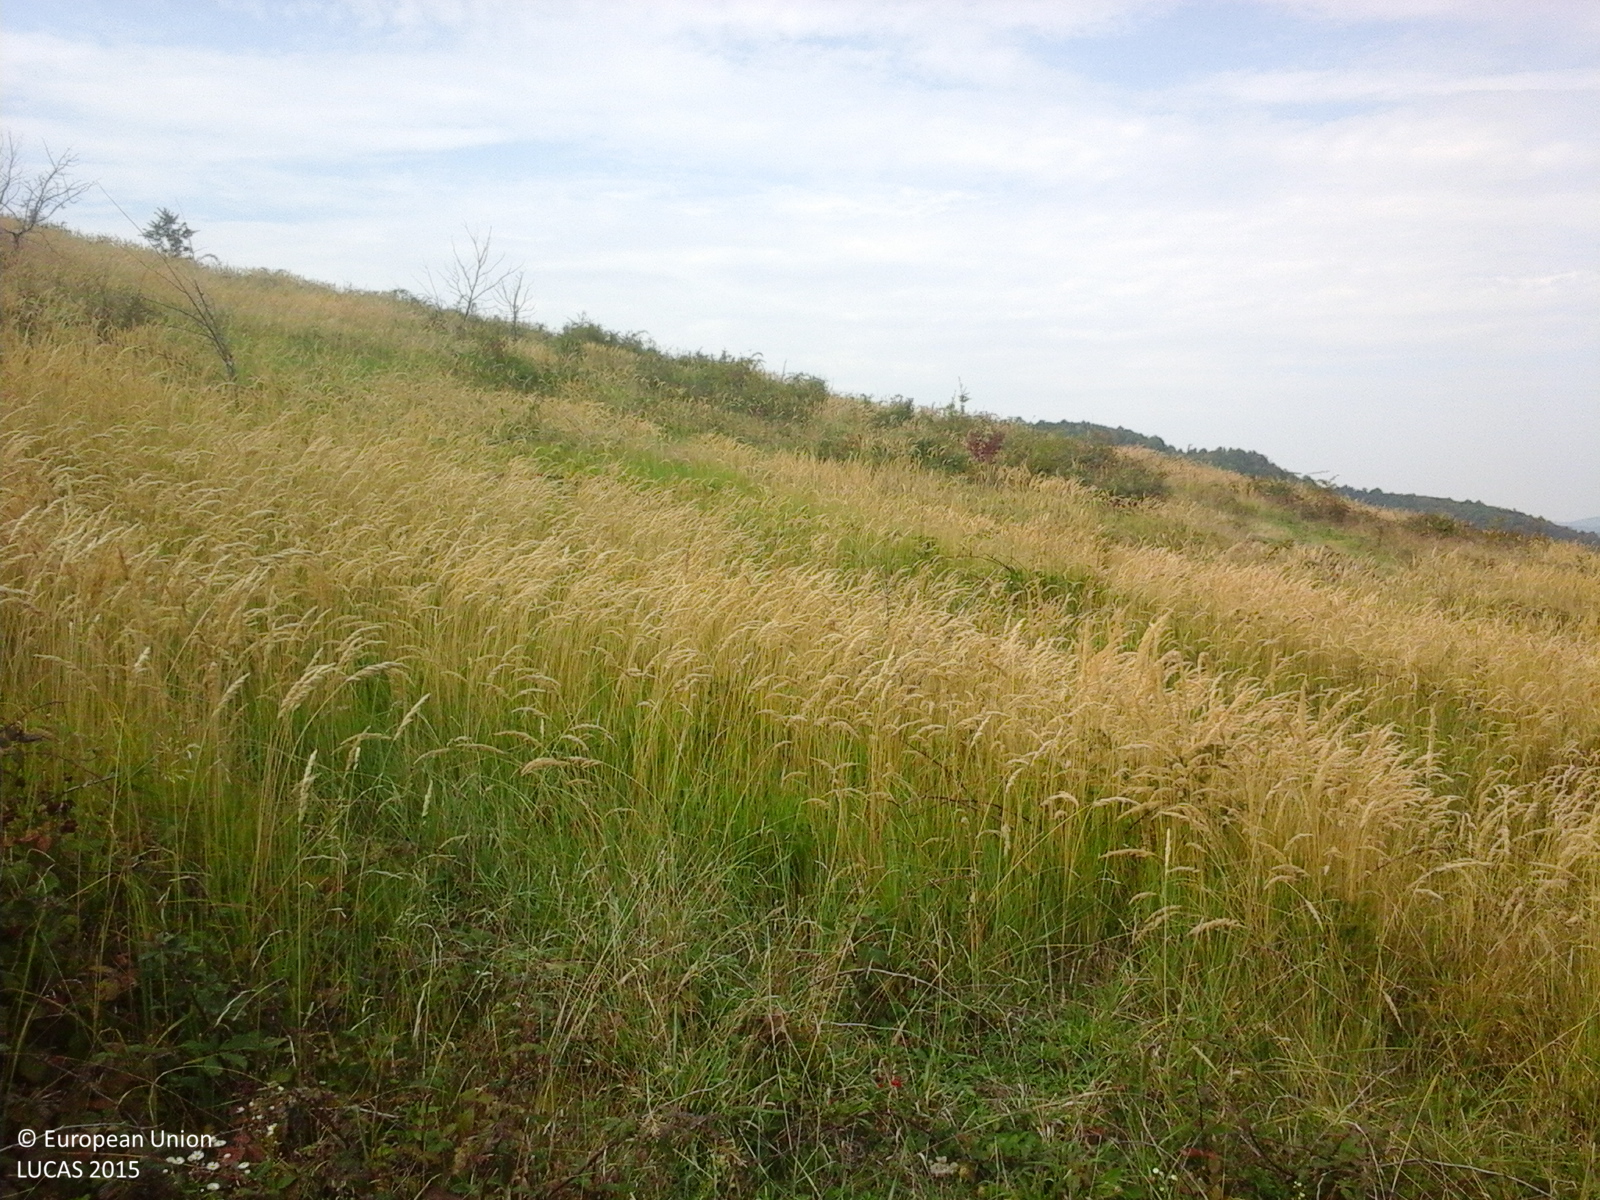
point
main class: Grassland
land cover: Grassland with sparse tree/shrub cover
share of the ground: > 75 %
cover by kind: herbaceous plants 85 %, shrubs 10 %, broadleaved forest trees 5 %
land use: Fallow land
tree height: < 5 m
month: September
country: RO
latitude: 45.7377
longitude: 22.8395
